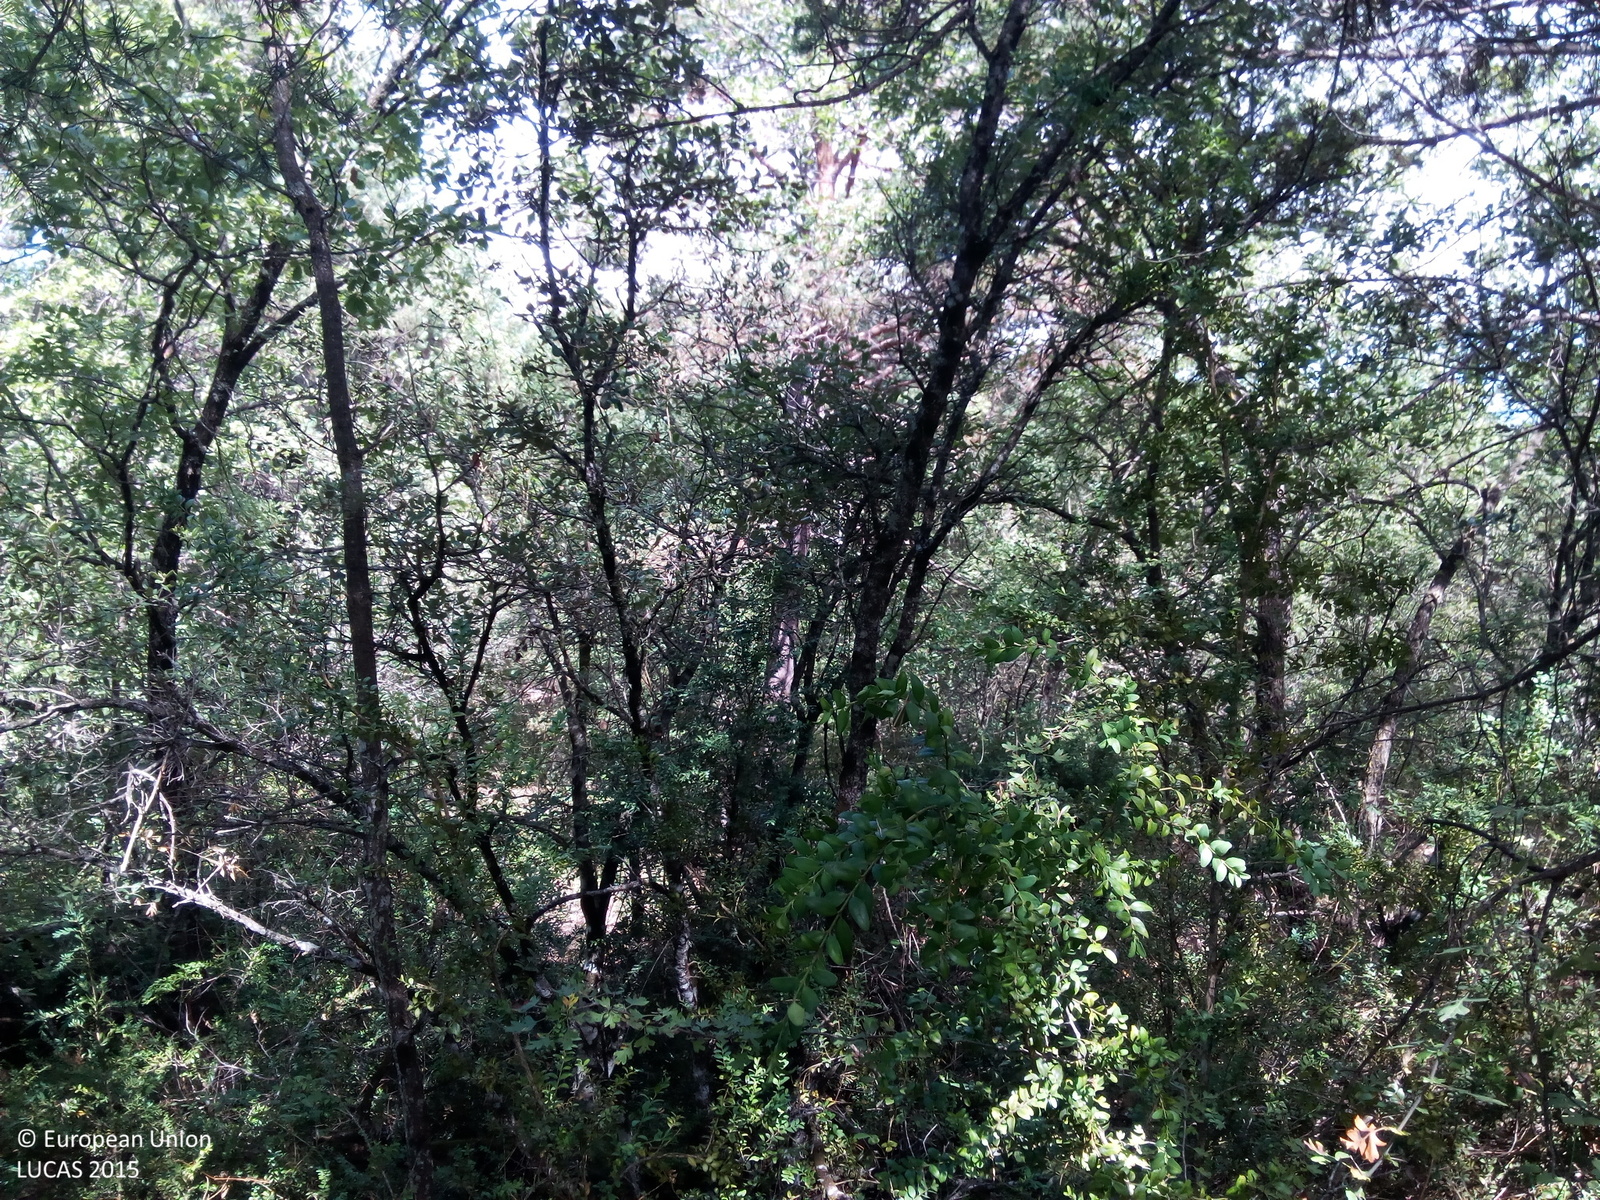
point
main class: Woodland
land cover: Pine dominated mixed woodland
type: coniferous forest of the mediterranean region
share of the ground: > 75 %
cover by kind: coniferous forest trees 40 %, shrubs 30 %, broadleaved forest trees 20 %, herbaceous plants 10 %
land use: Semi-natural and natural areas not in use
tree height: > 5 m
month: August
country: ES
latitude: 42.3001
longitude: 0.3376
